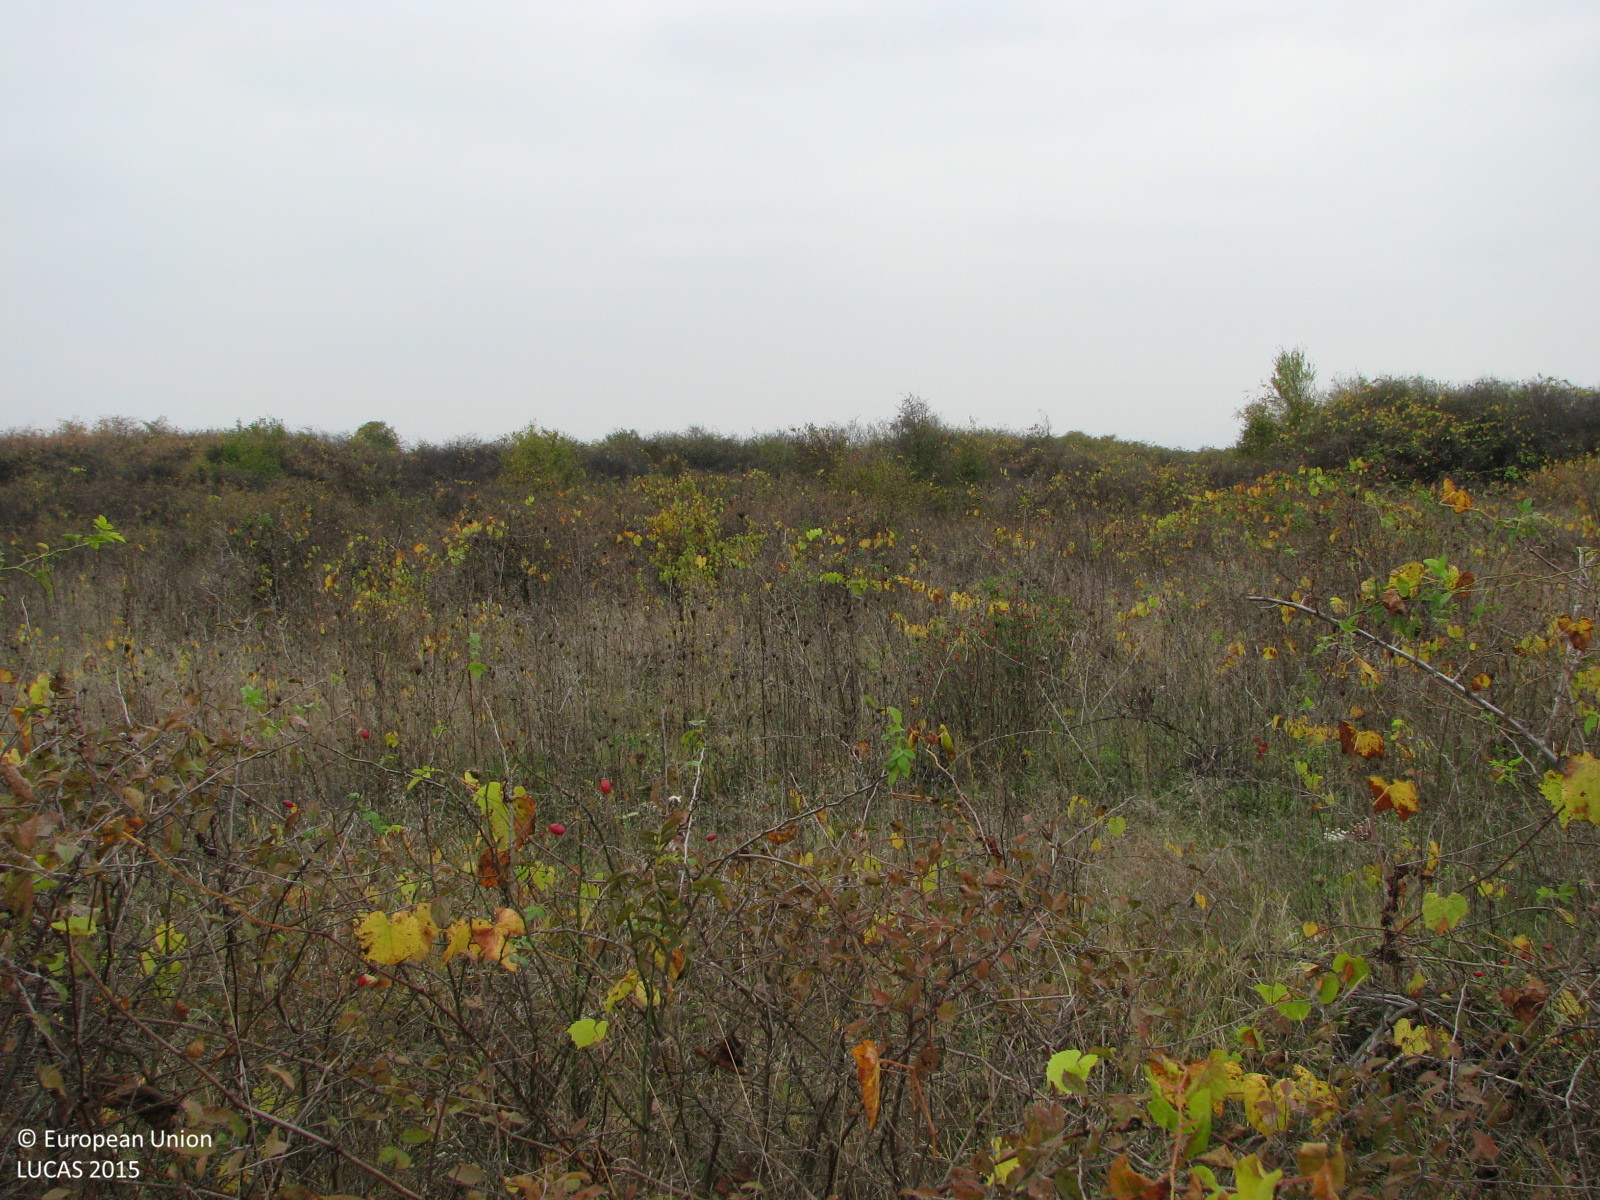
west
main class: Shrubland
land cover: Shrubland without tree cover
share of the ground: > 75 %
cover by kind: shrubs 80 %, herbaceous plants 20 %
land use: Semi-natural and natural areas not in use
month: October
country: BG
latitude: 42.5760
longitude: 26.7291
